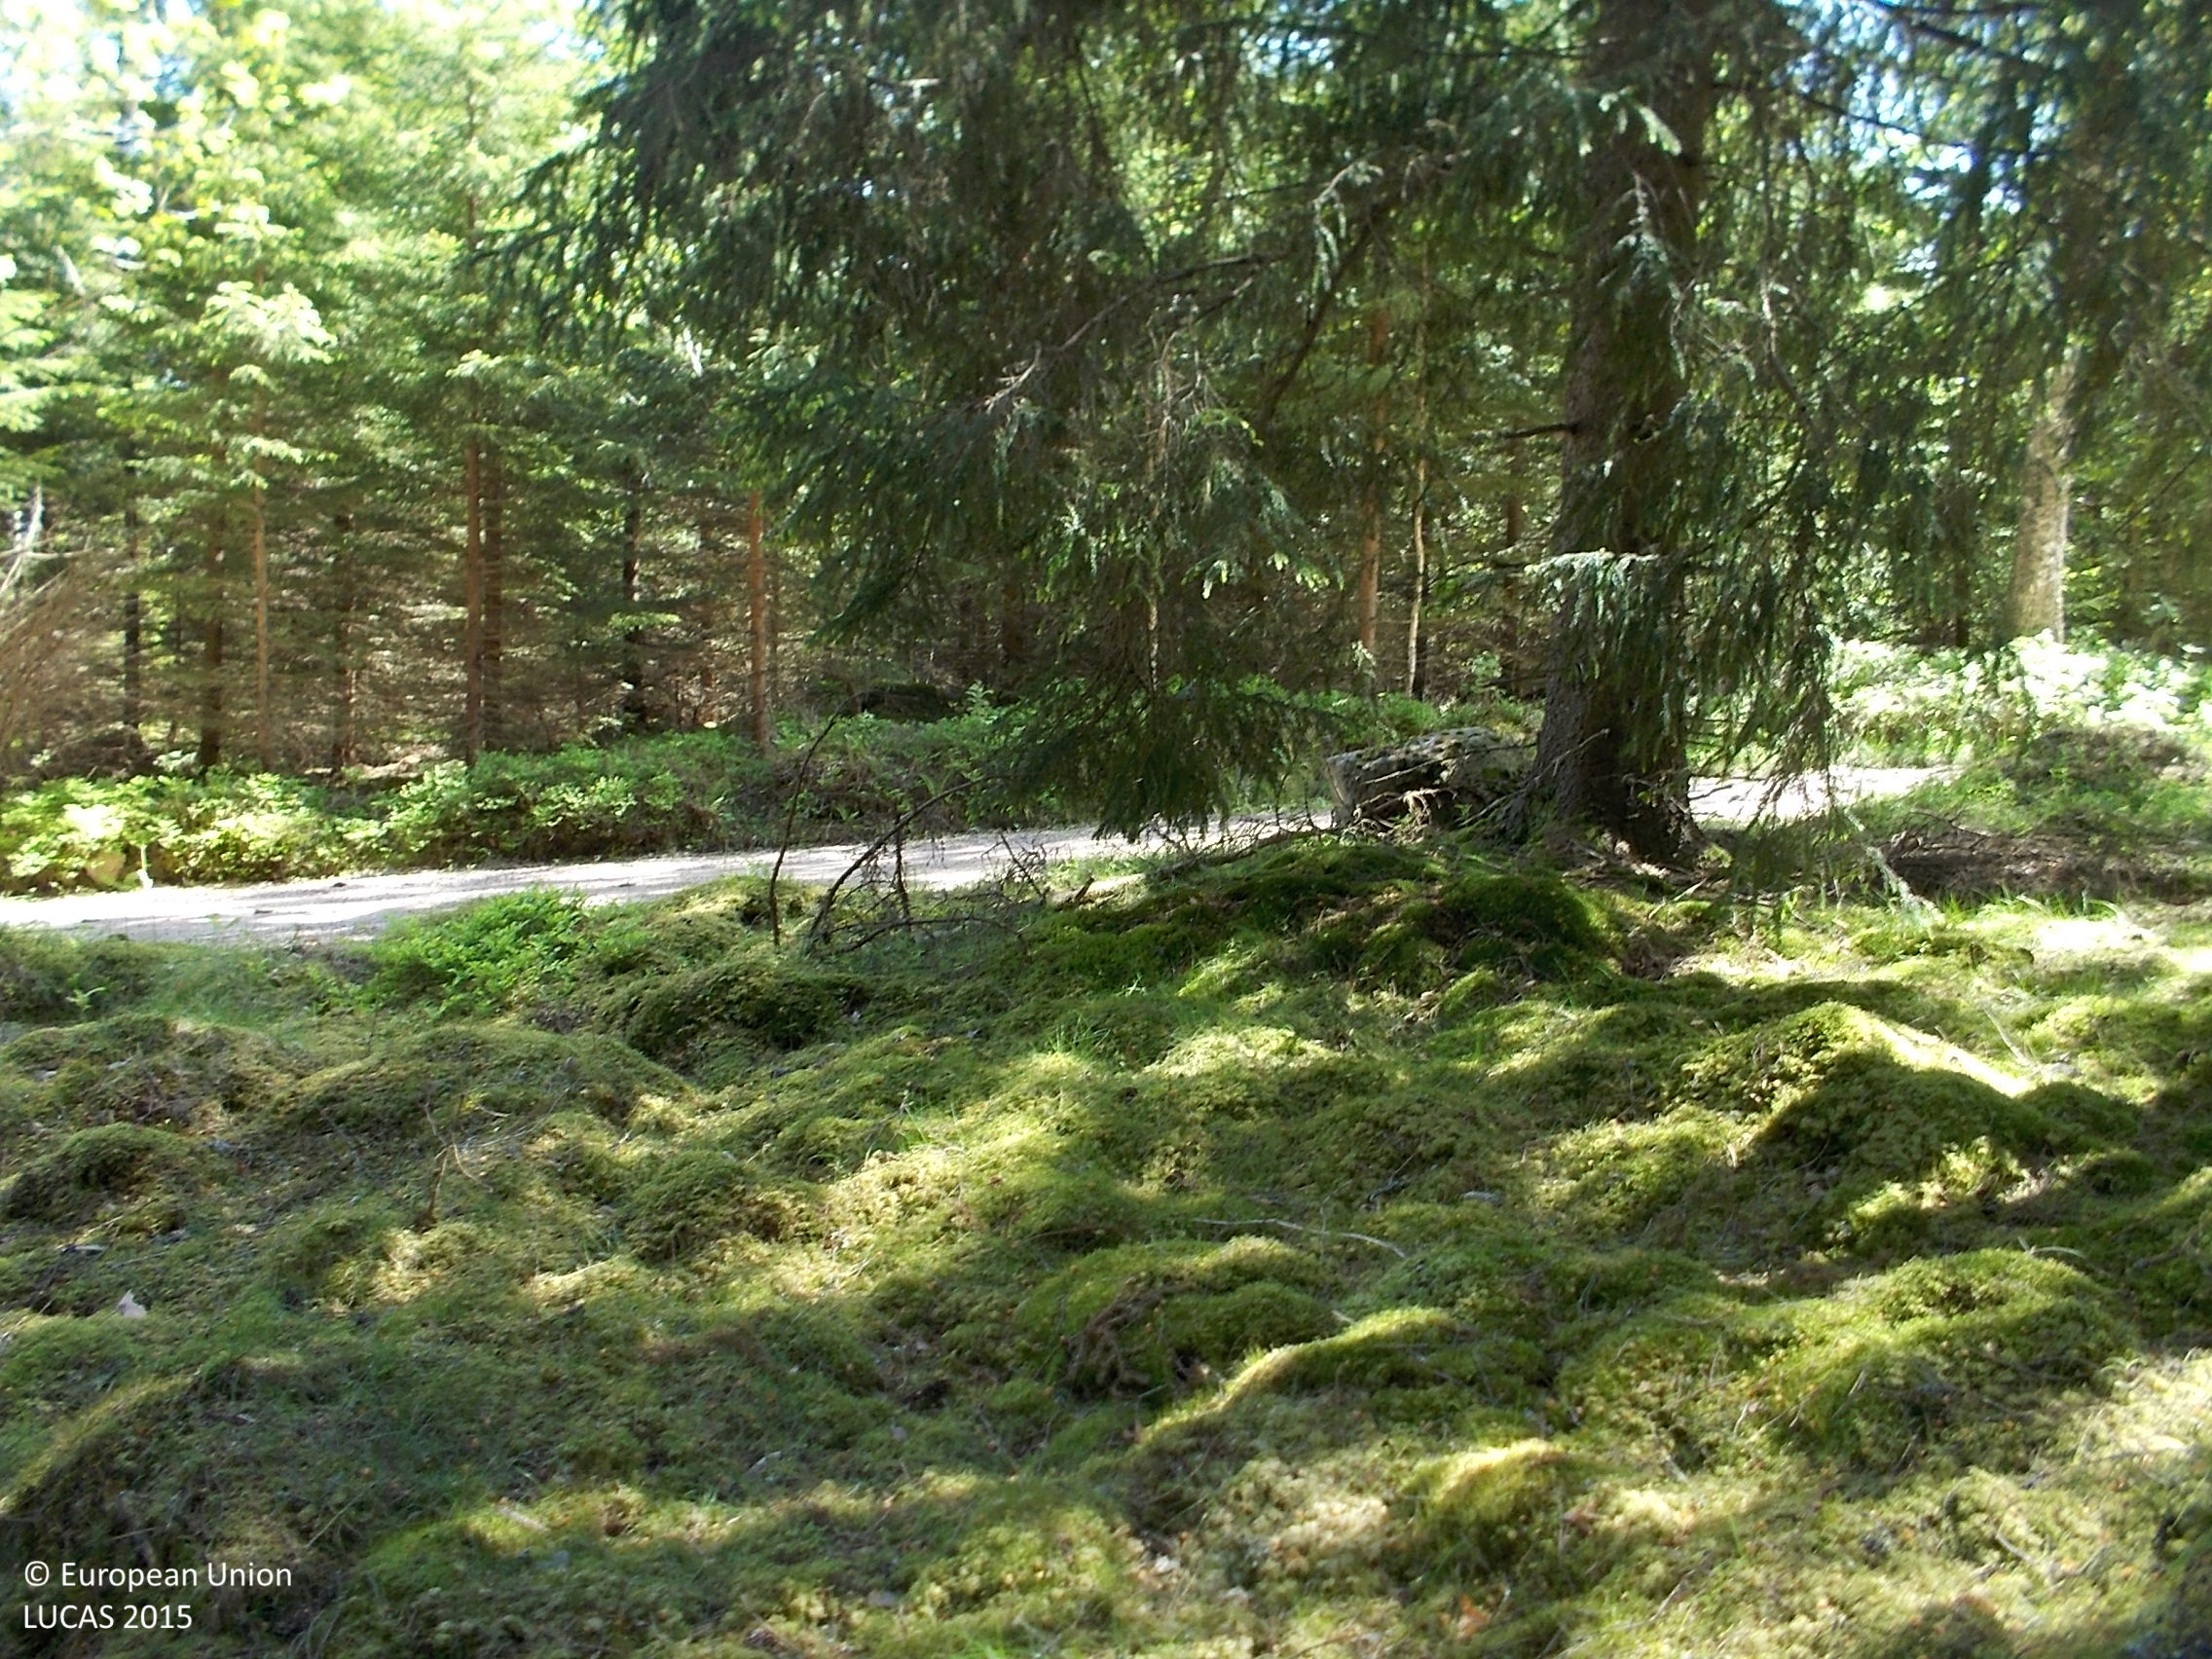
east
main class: Woodland
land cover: Spruce dominated coniferous woodland
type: boreal forest
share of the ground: > 75 %
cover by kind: coniferous forest trees 85 %, shrubs 5 %, herbaceous plants 5 %, lichens and mosses 5 %
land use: Forestry
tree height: > 5 m
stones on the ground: < 10 %
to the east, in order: Spruce dominated coniferous woodland; Paved roads, cycling and walking lanes; Spruce dominated coniferous woodland; Grass margins; Spruce dominated coniferous woodland; Spruce dominated mixed woodland
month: June
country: SE
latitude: 57.7485
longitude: 13.2380
